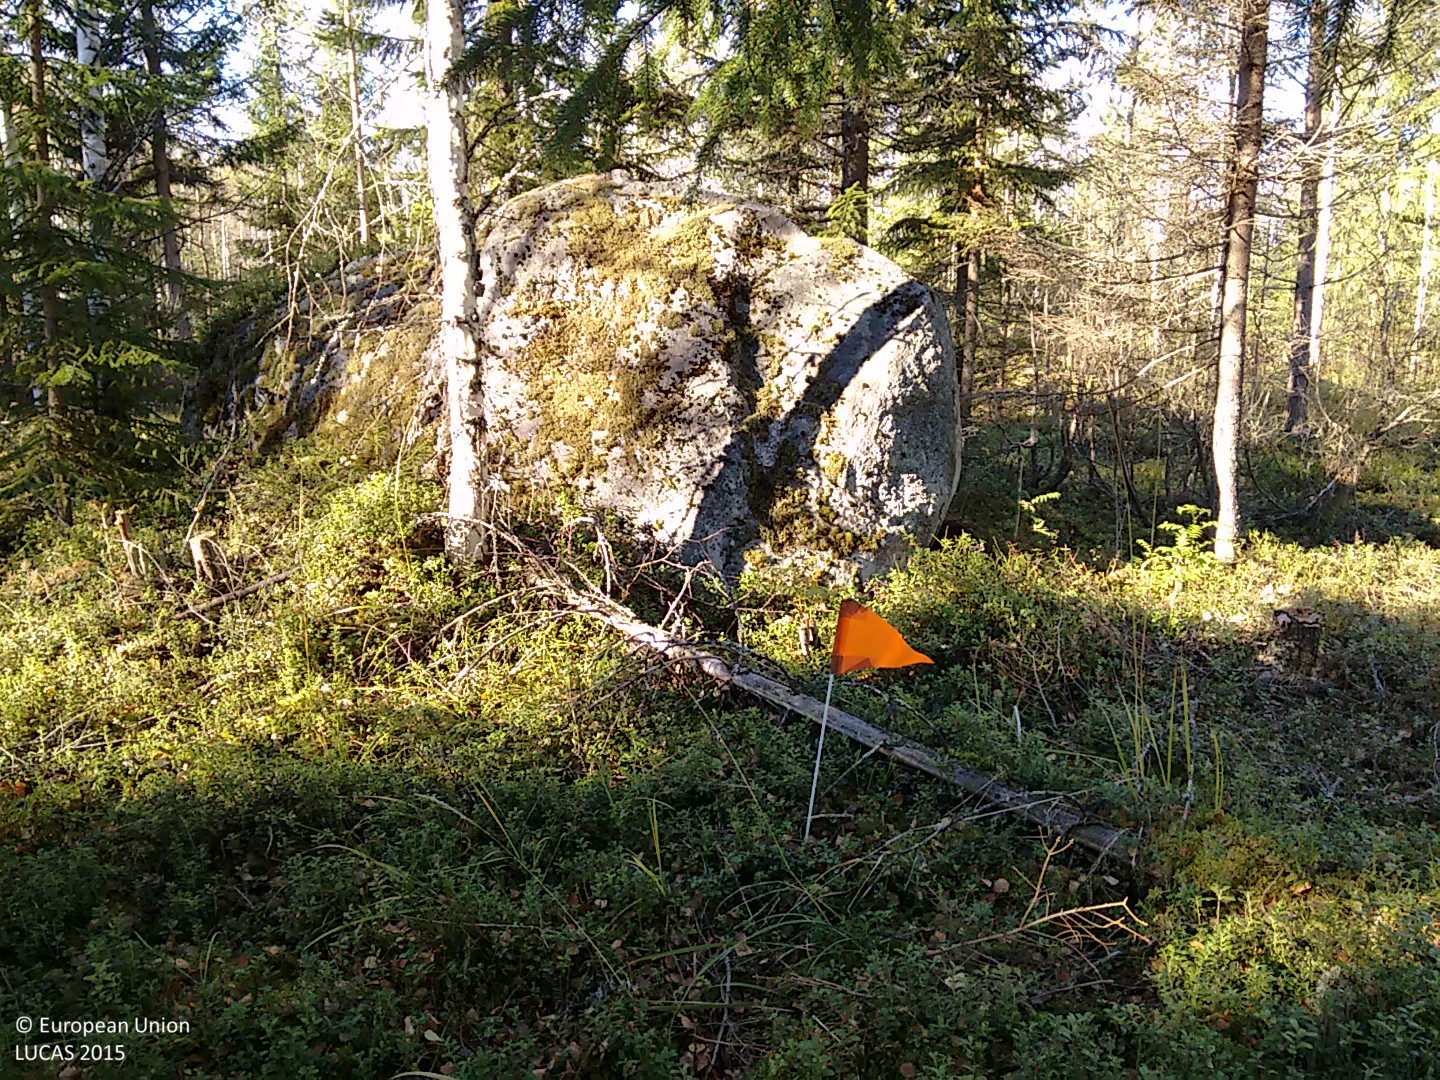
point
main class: Woodland
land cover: Other mixed woodland
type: boreal forest
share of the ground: > 75 %
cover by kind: broadleaved forest trees 45 %, coniferous forest trees 35 %, shrubs 20 %
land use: Forestry
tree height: > 5 m
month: October
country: FI
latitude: 62.4166
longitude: 26.1382
